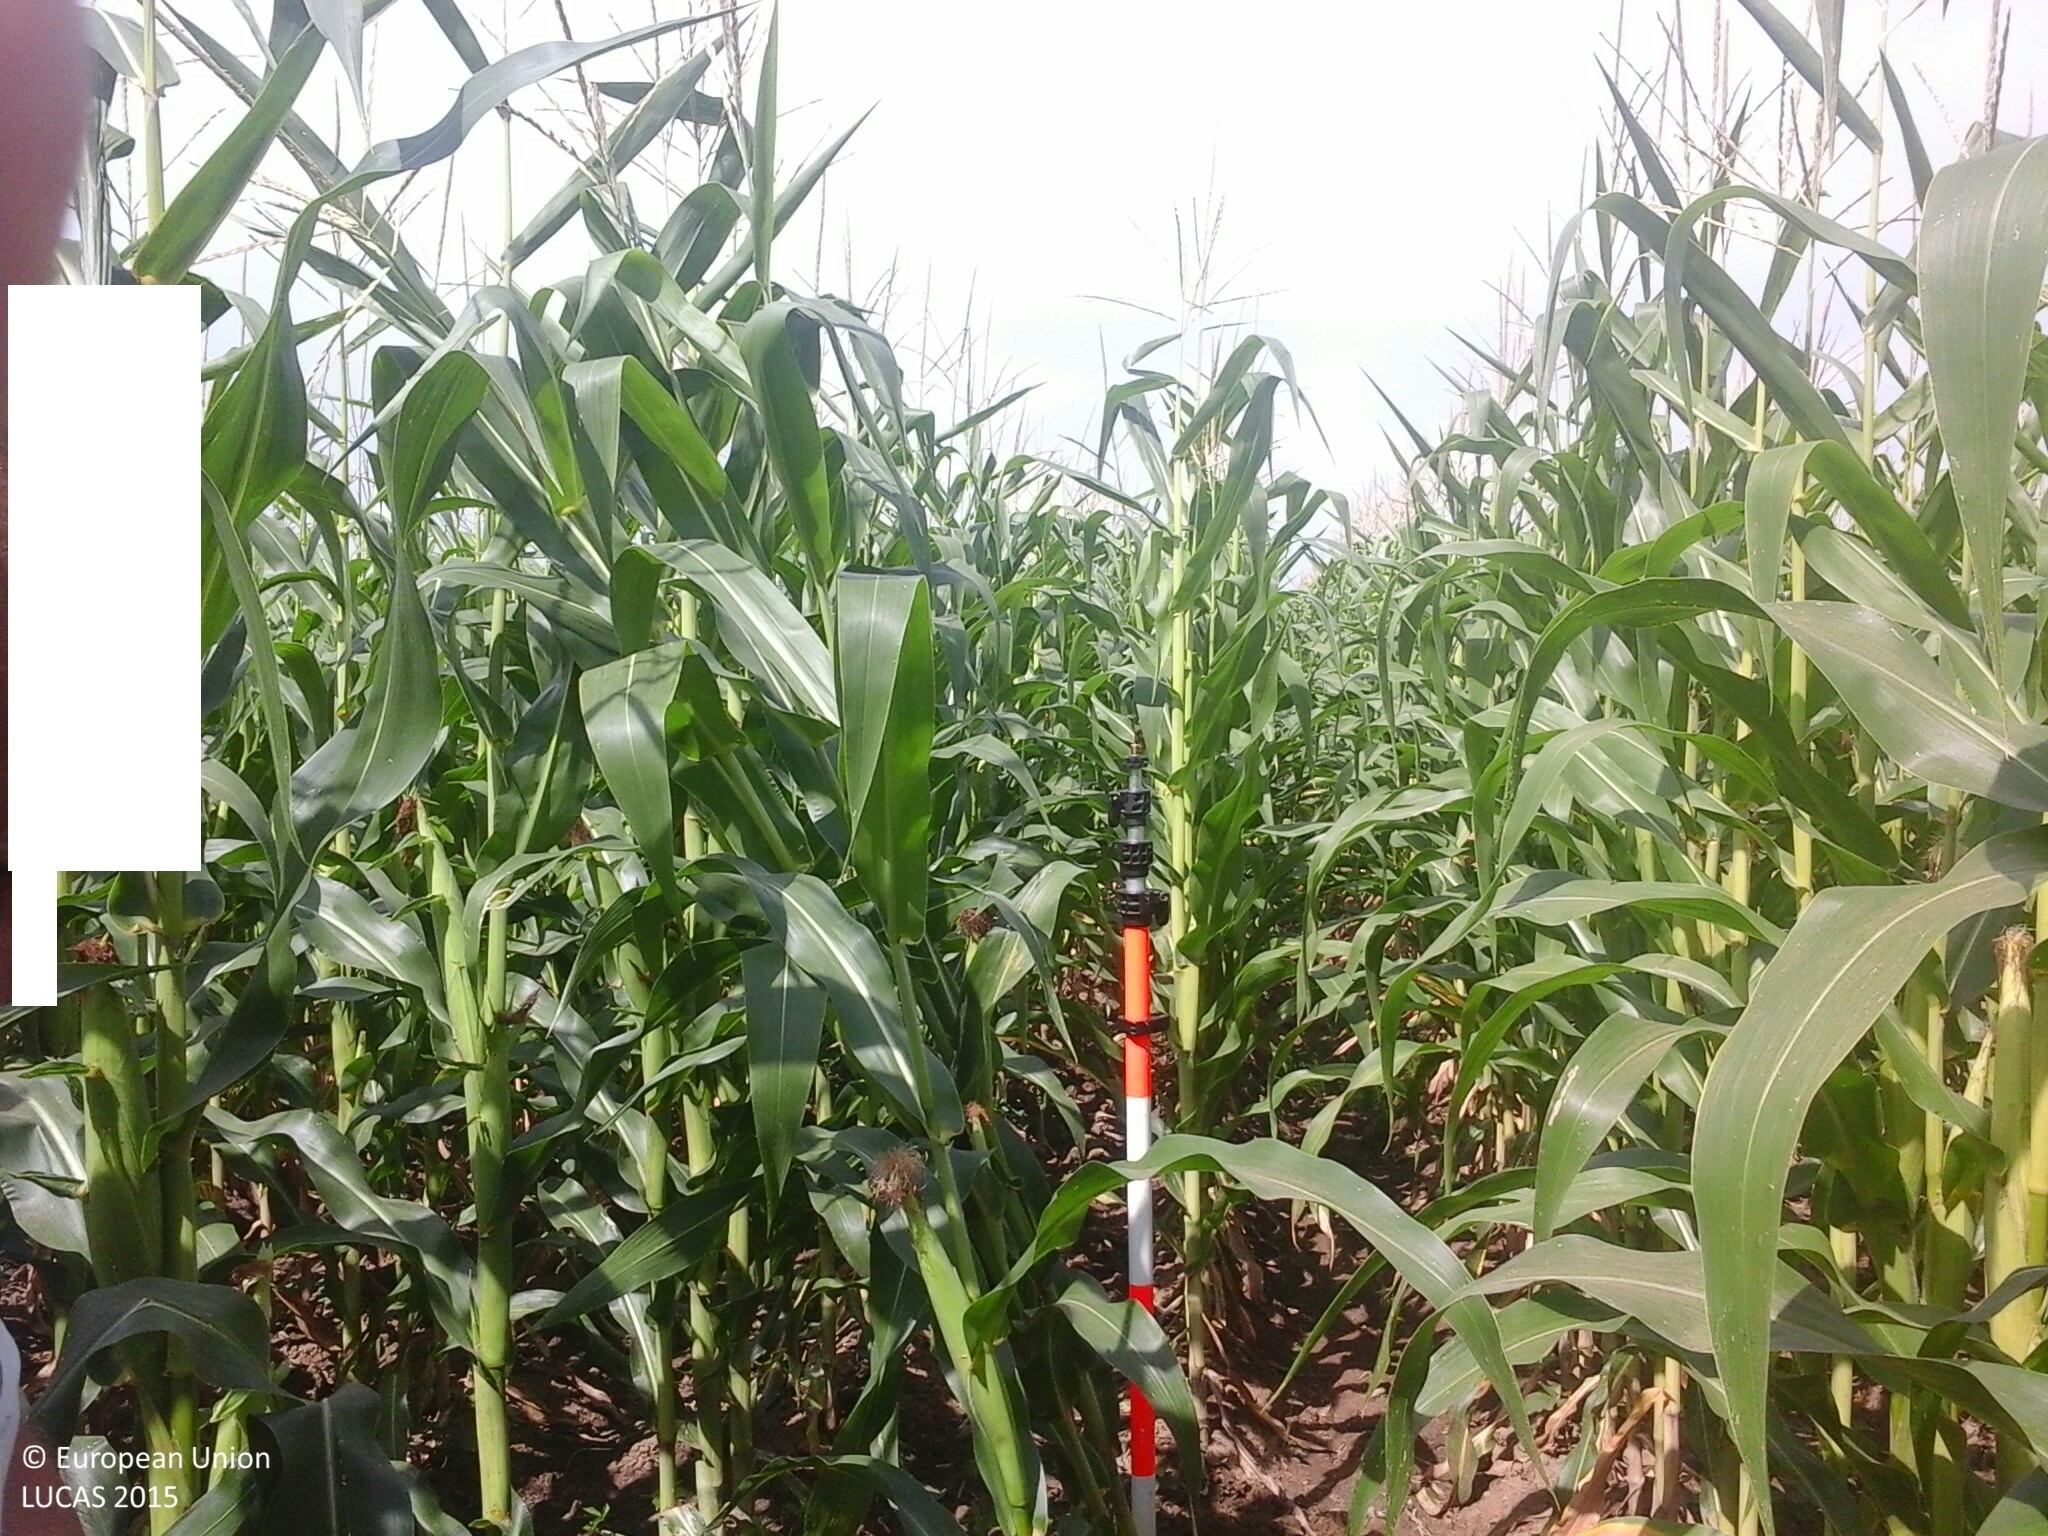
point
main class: Cropland
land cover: Maize
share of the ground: > 75 %
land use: Agriculture (excluding fallow land and kitchen gardens)
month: July
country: HU
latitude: 48.2801
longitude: 22.2797
